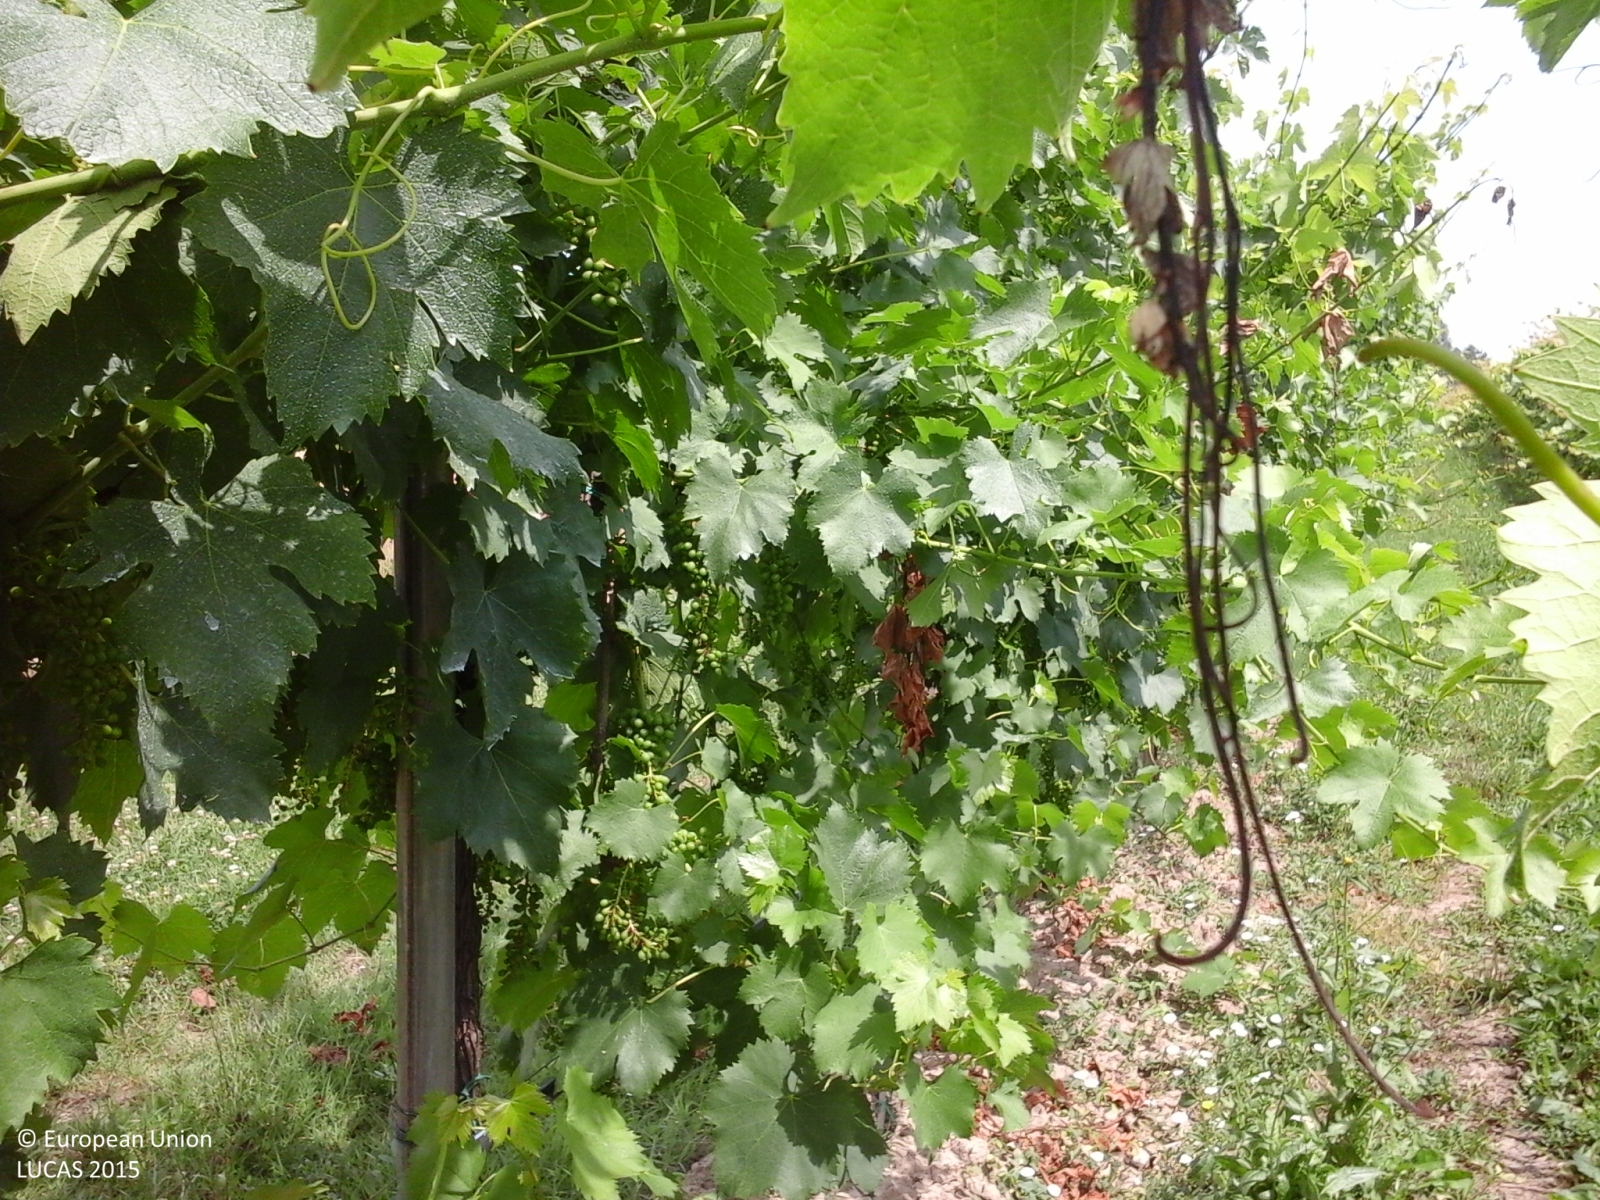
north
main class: Cropland
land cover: Vineyards
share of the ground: 50 - 75 %
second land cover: Grassland without tree/shrub cover
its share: > 75 %
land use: Agriculture (excluding fallow land and kitchen gardens)
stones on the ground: < 10 %
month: June
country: IT
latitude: 44.6519
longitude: 11.0444
